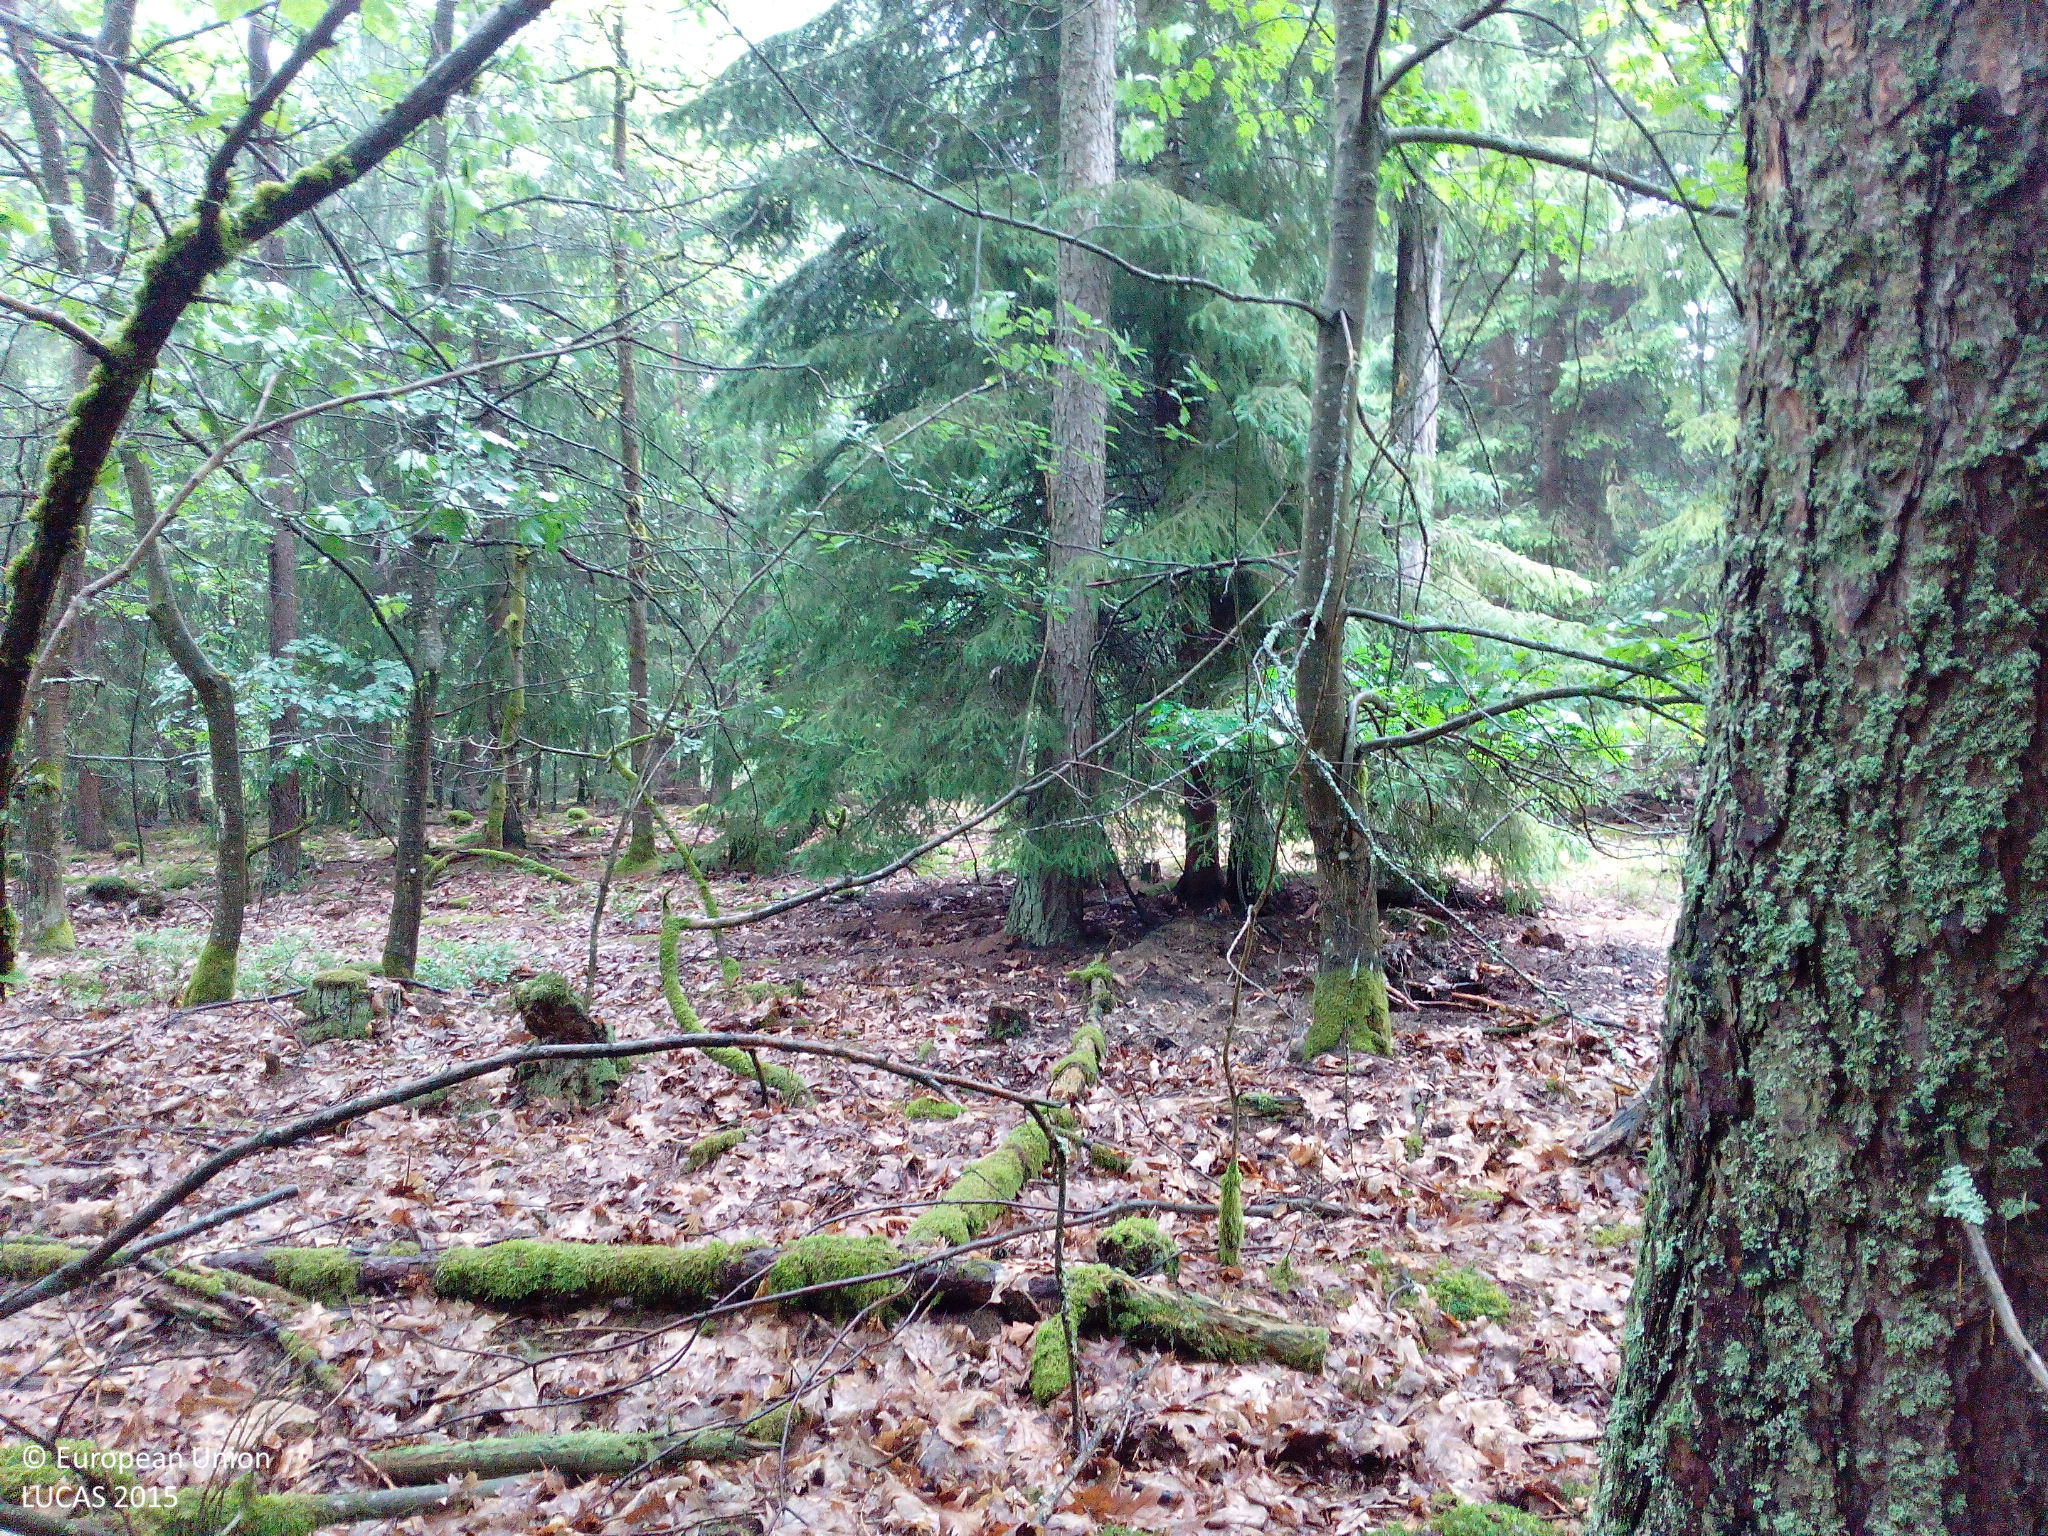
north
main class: Woodland
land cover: Other mixed woodland
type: hemiboreal forest and nemoral coniferous forest and mixed broadleaved-coniferous forest
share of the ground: > 75 %
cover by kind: coniferous forest trees 75 %, broadleaved forest trees 25 %
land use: Forestry
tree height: > 5 m
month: June
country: DE
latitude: 49.2632
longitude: 12.2119
